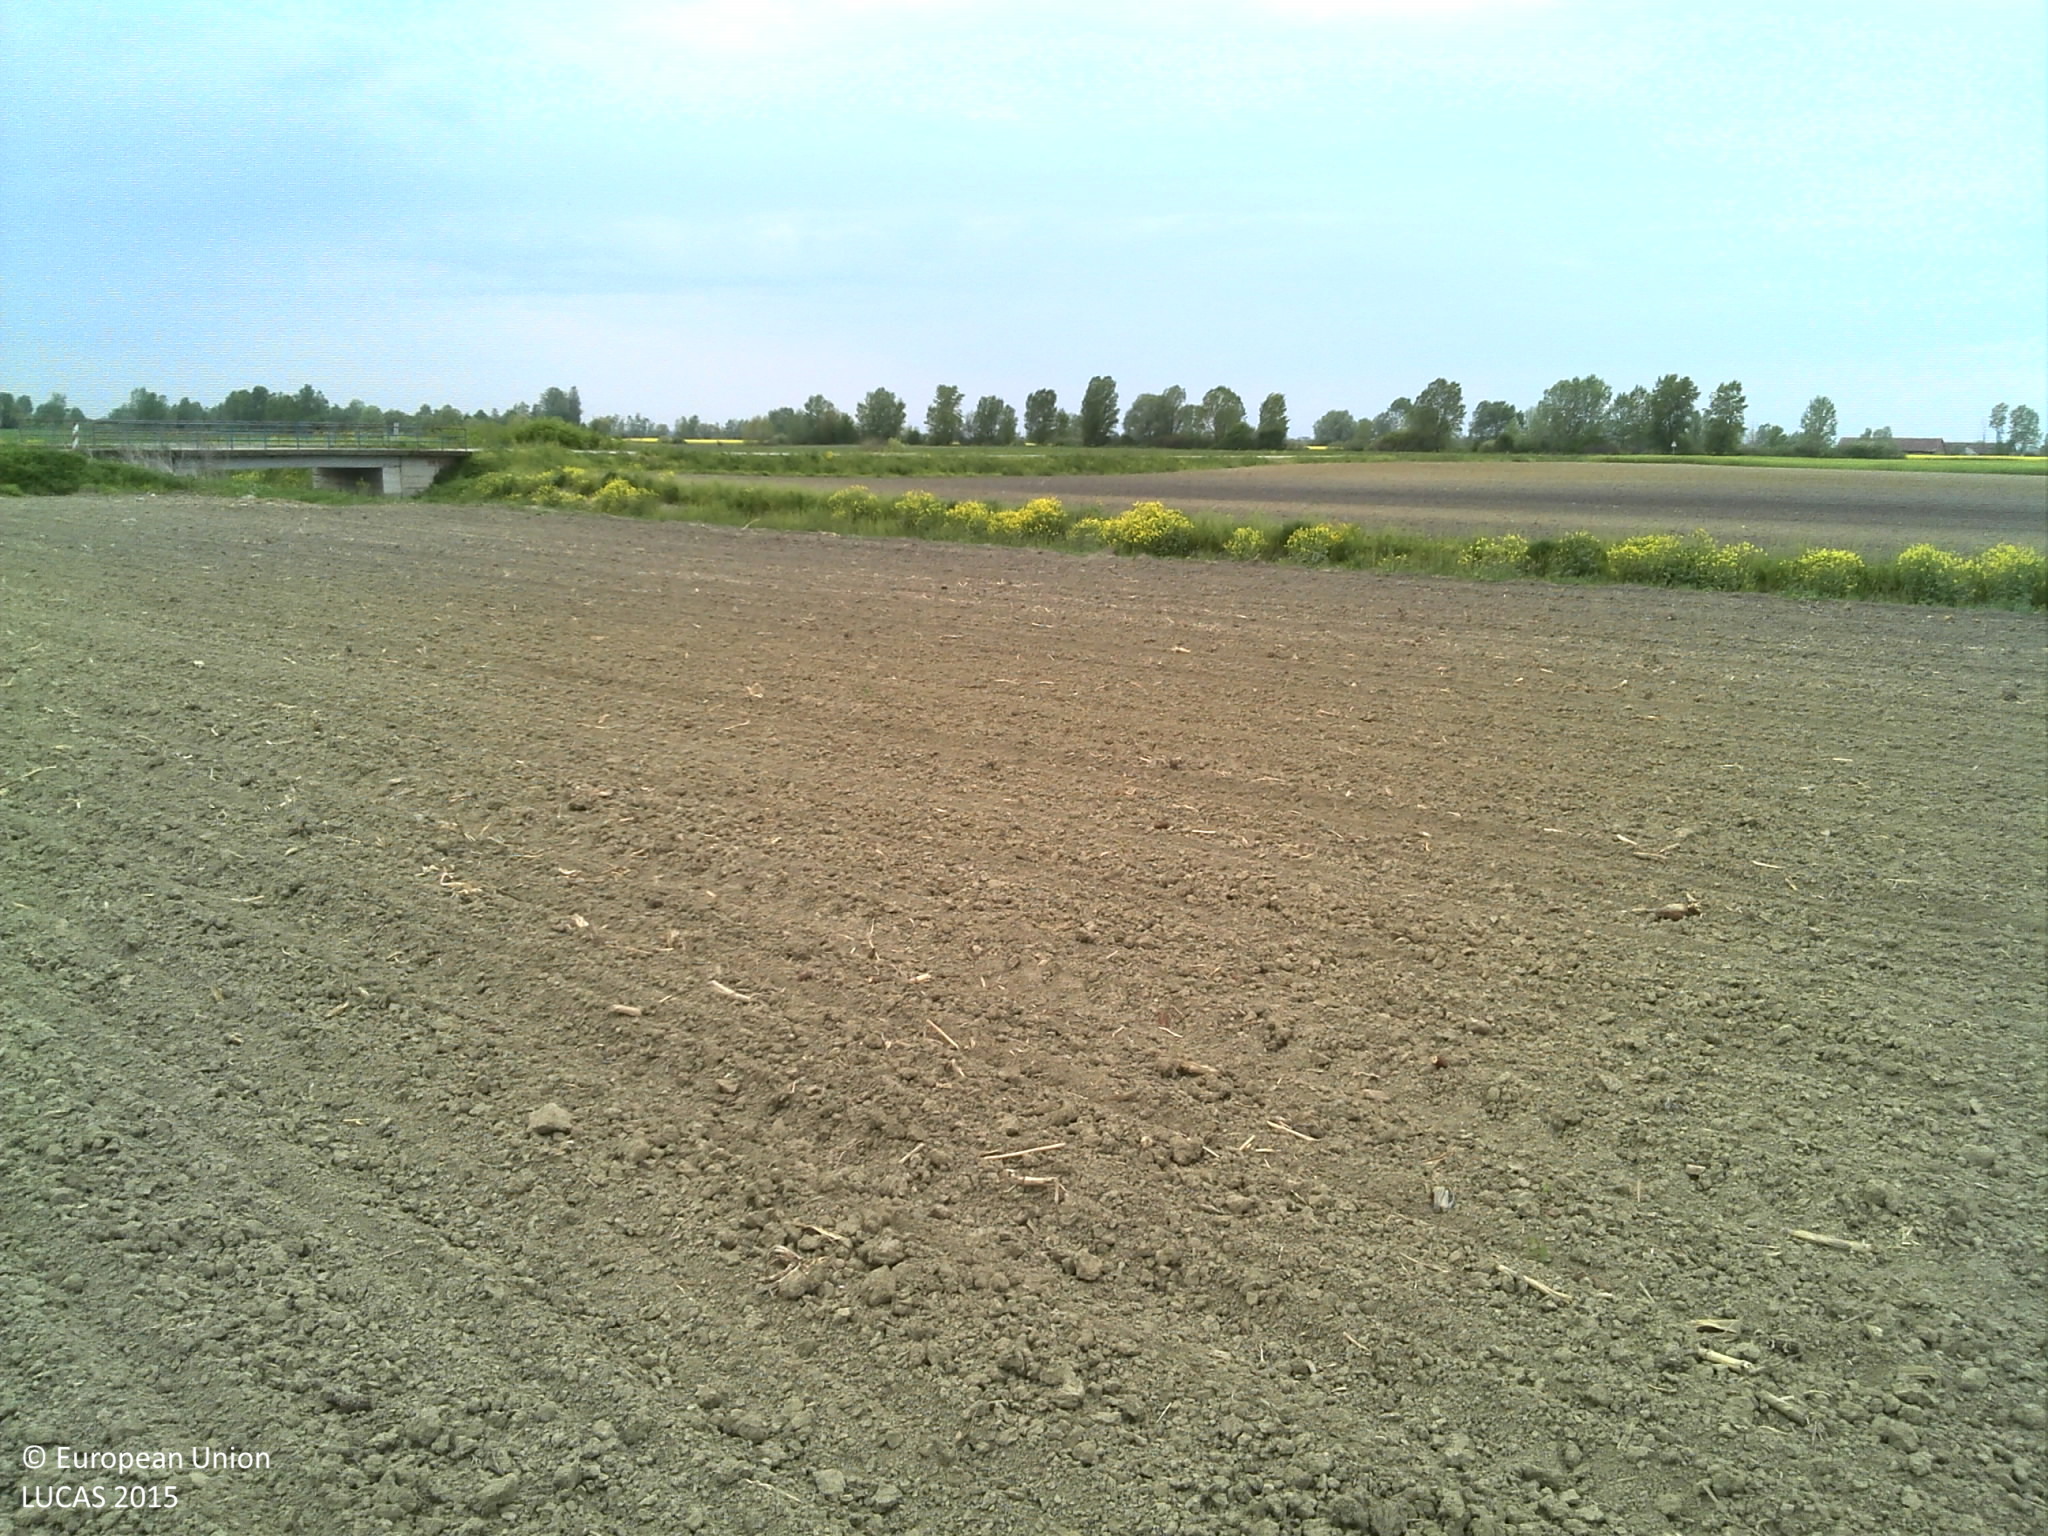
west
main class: Cropland
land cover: Soya
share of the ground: < 10 %
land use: Agriculture (excluding fallow land and kitchen gardens)
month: April
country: HR
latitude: 44.9388
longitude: 18.9915
